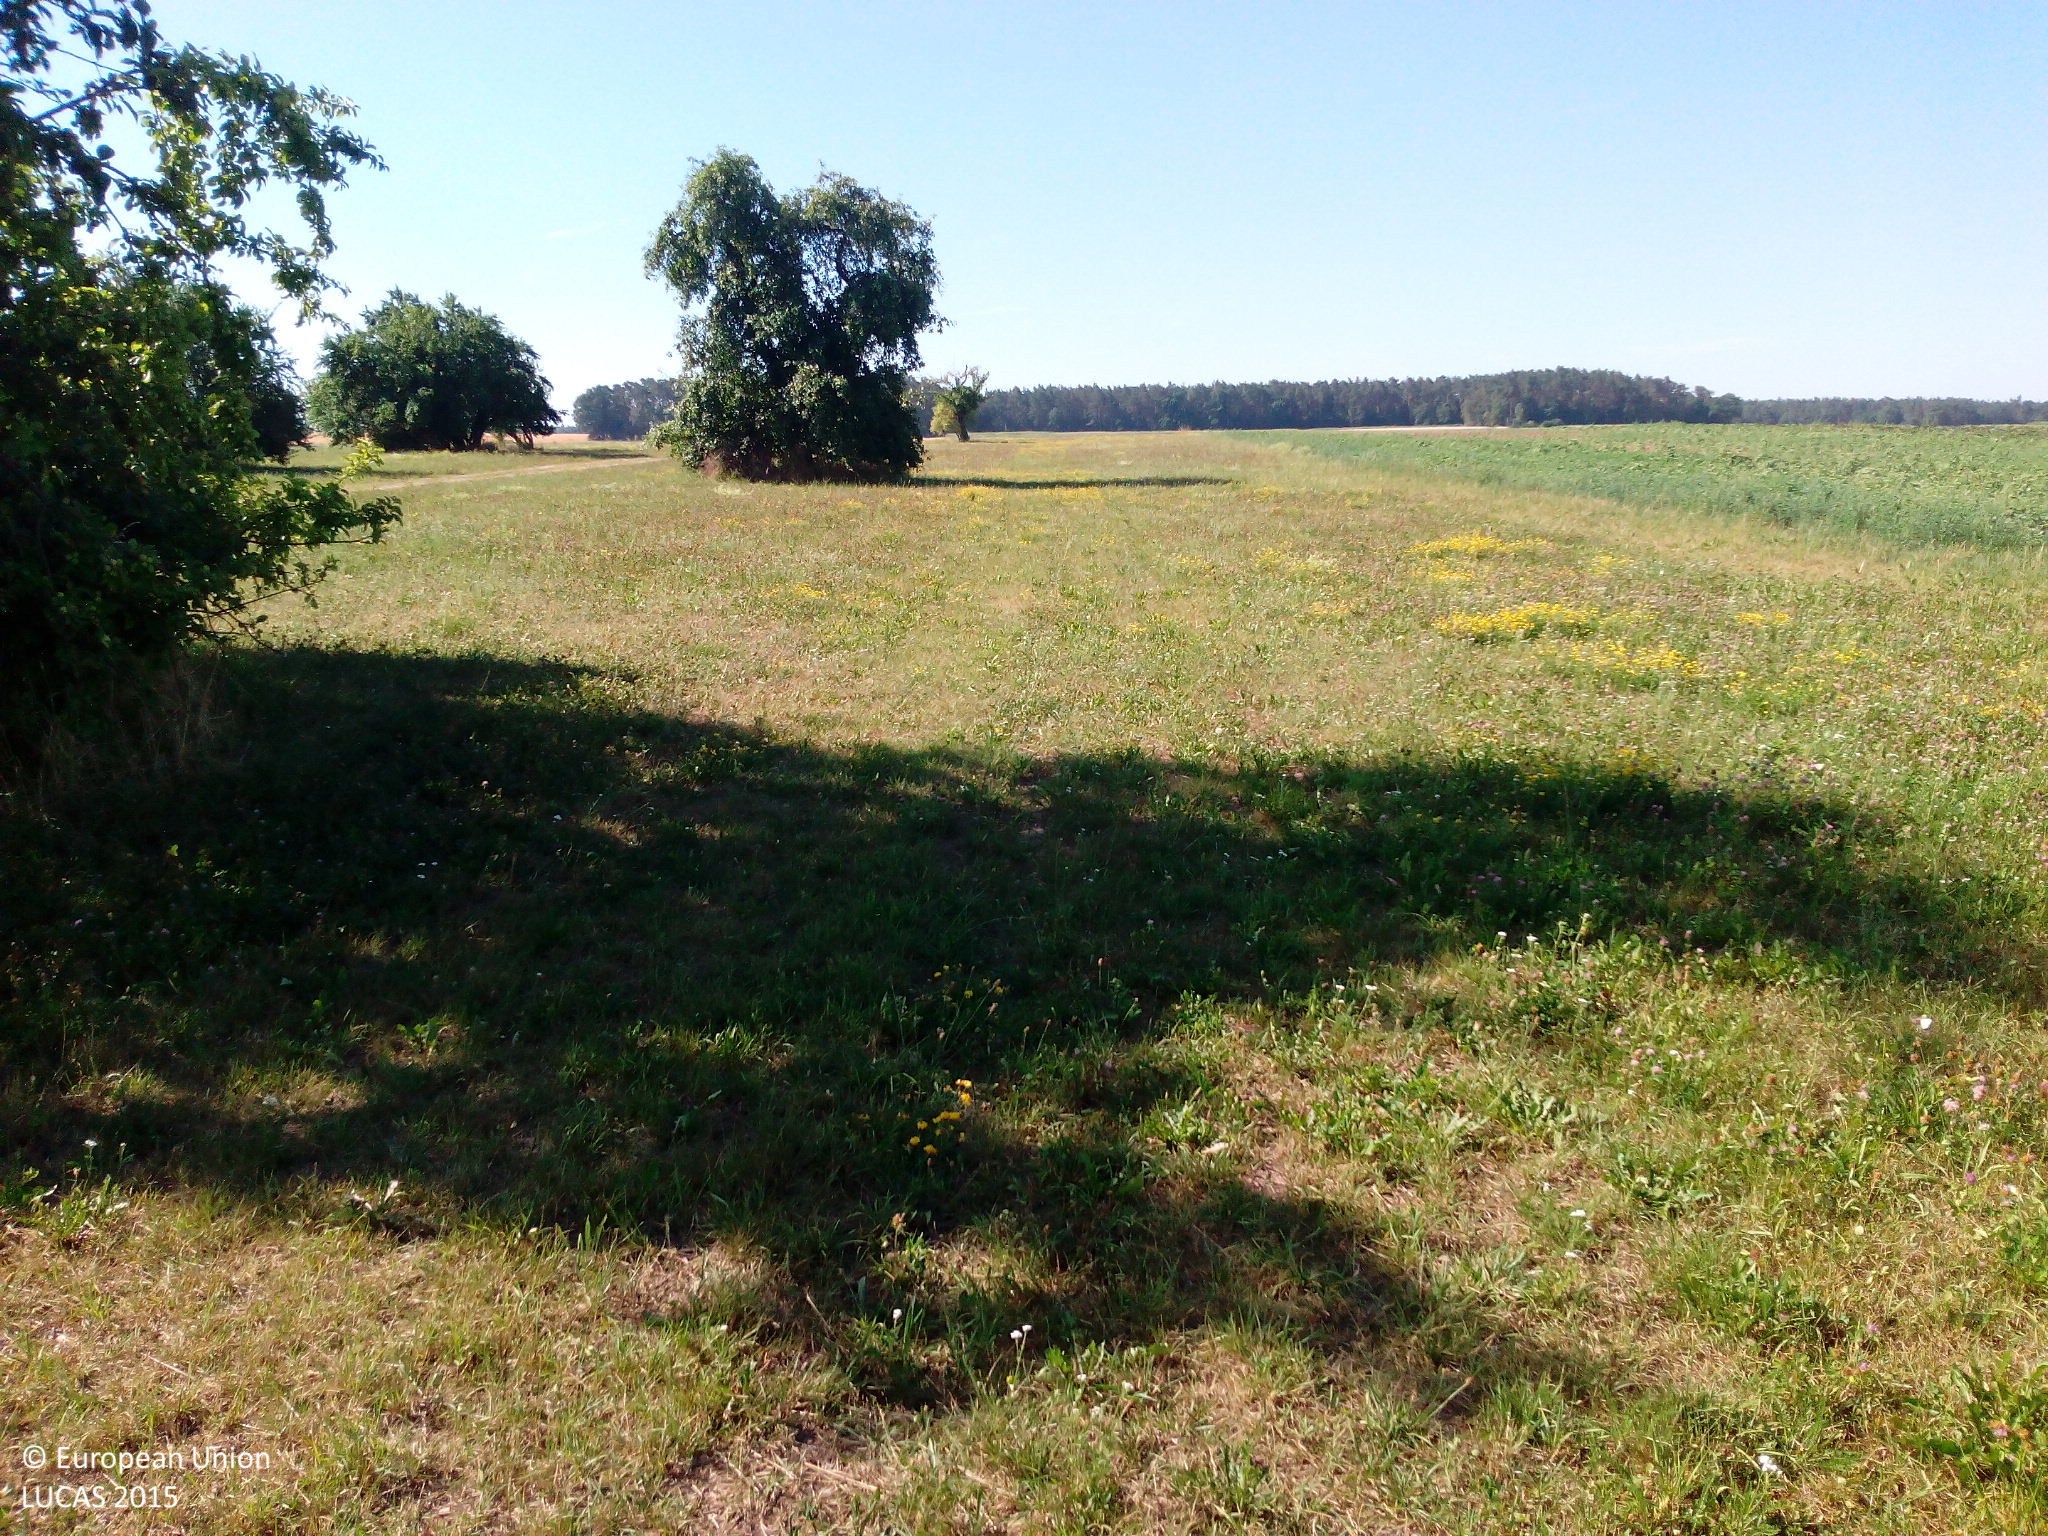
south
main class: Cropland
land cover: Apple fruit
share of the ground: < 10 %
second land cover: Grassland without tree/shrub cover
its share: > 75 %
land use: Agriculture (excluding fallow land and kitchen gardens)
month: July
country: DE
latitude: 49.4071
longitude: 10.9230
